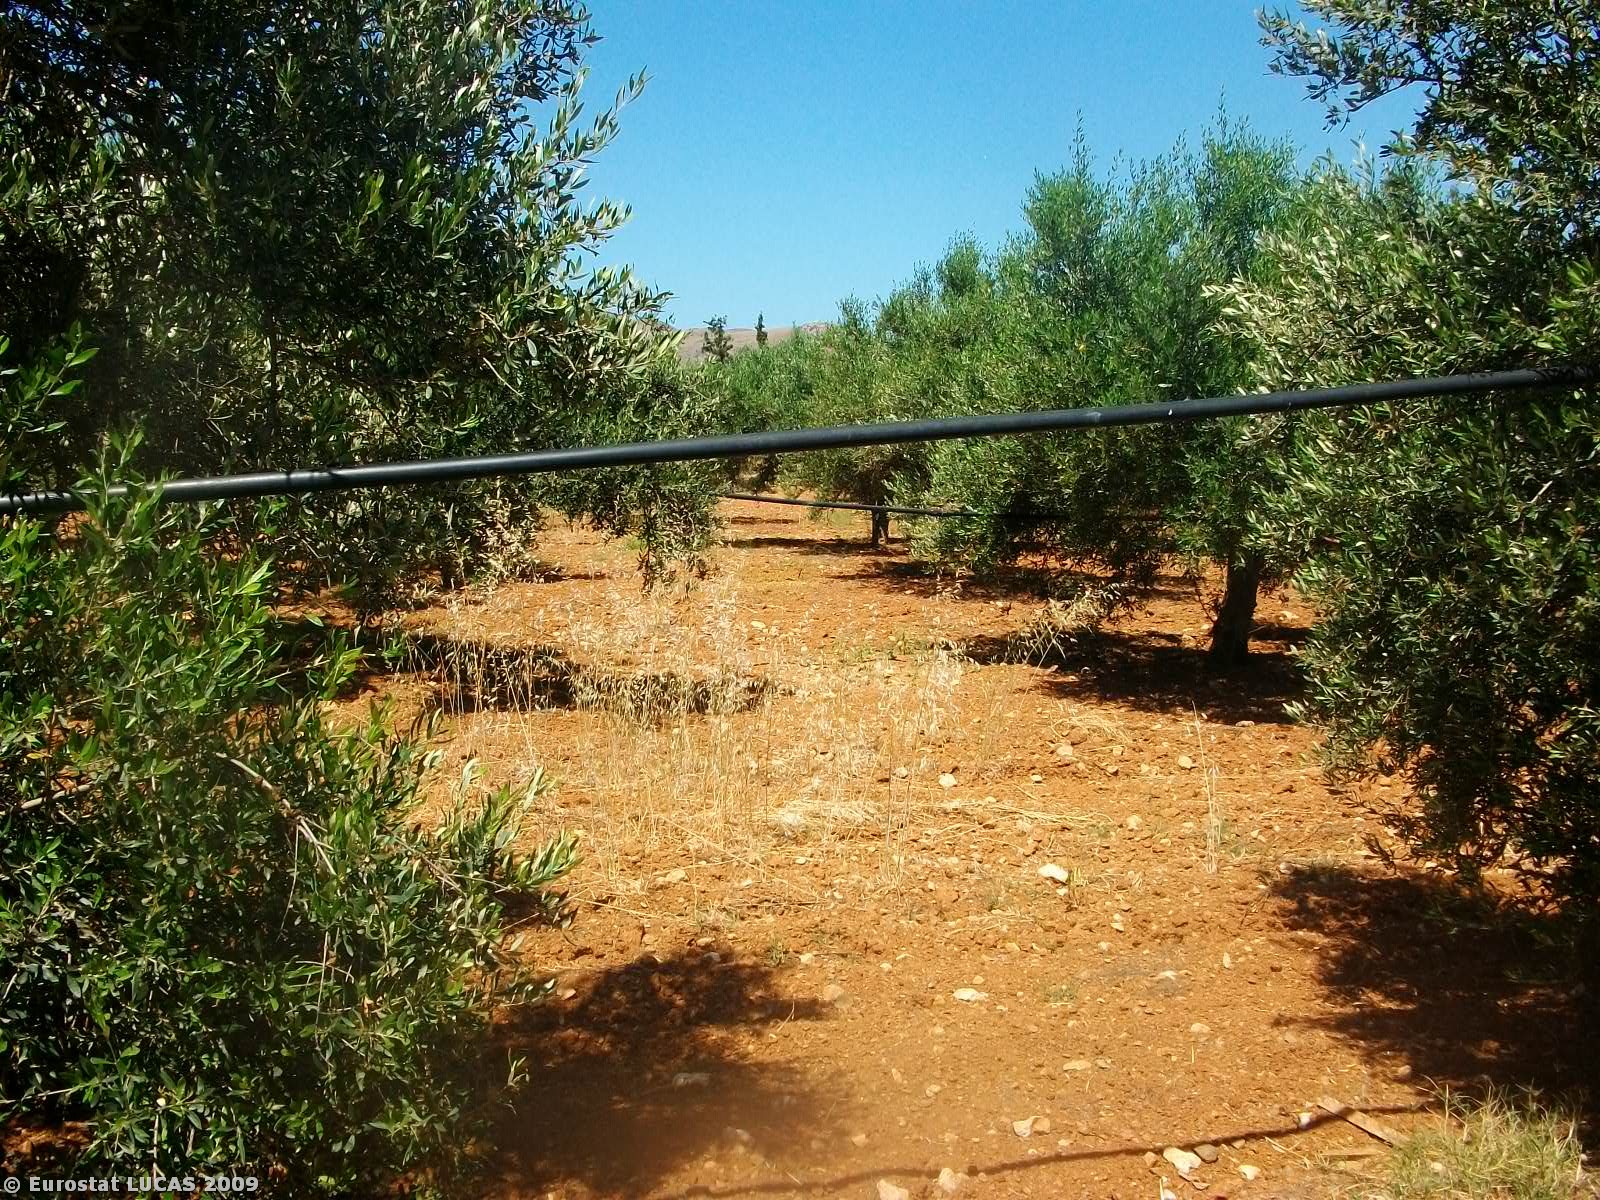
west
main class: Cropland
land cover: Olive groves
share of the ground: > 75 %
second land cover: Bare land
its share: > 75 %
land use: Agriculture (excluding fallow land and kitchen gardens)
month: June
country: GR
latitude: 35.0155
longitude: 24.9214
